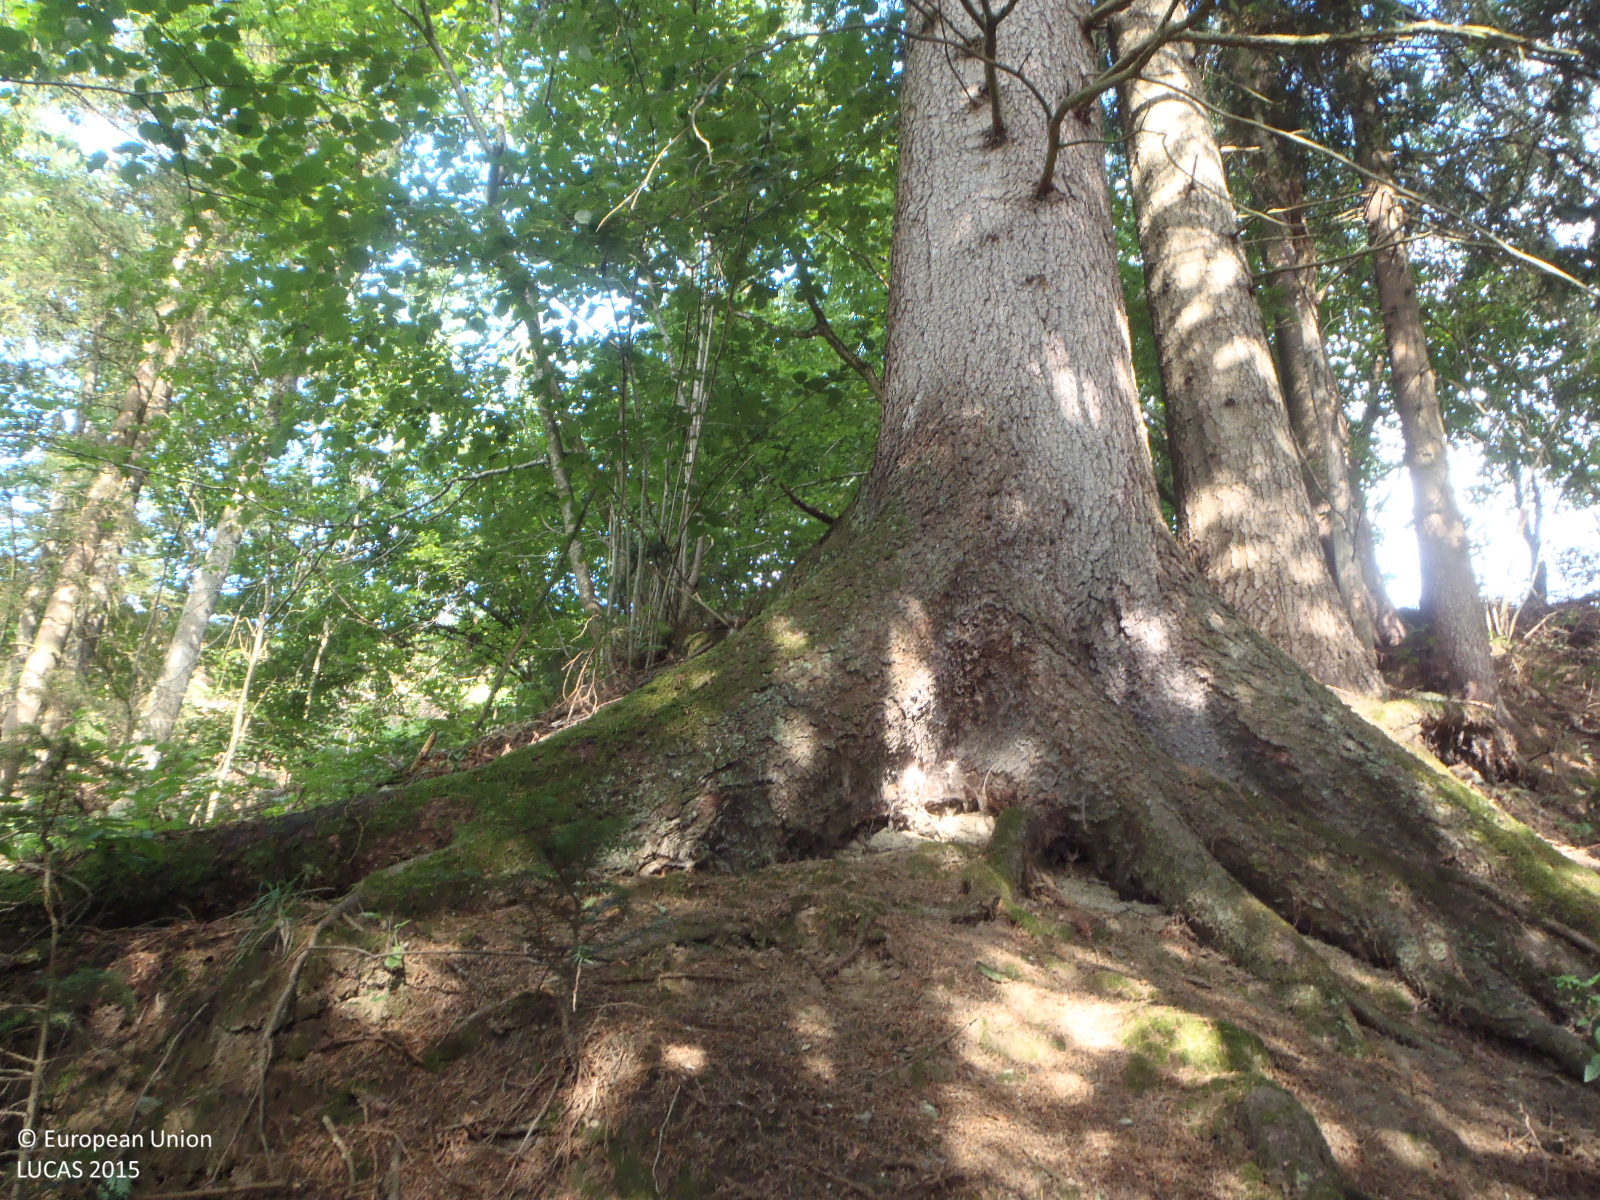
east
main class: Woodland
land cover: Spruce dominated mixed woodland
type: alpine coniferous forest
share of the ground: > 75 %
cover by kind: coniferous forest trees 70 %, broadleaved forest trees 30 %
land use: Forestry
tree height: > 5 m
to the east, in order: Spruce dominated mixed woodland; Grassland without tree/shrub cover; Broadleaved woodland; Tracks; Spruce dominated mixed woodland; Rivers and streams; Spruce dominated mixed woodland; Rivers and streams; Grassland without tree/shrub cover
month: July
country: AT
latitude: 47.4151
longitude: 11.8938
